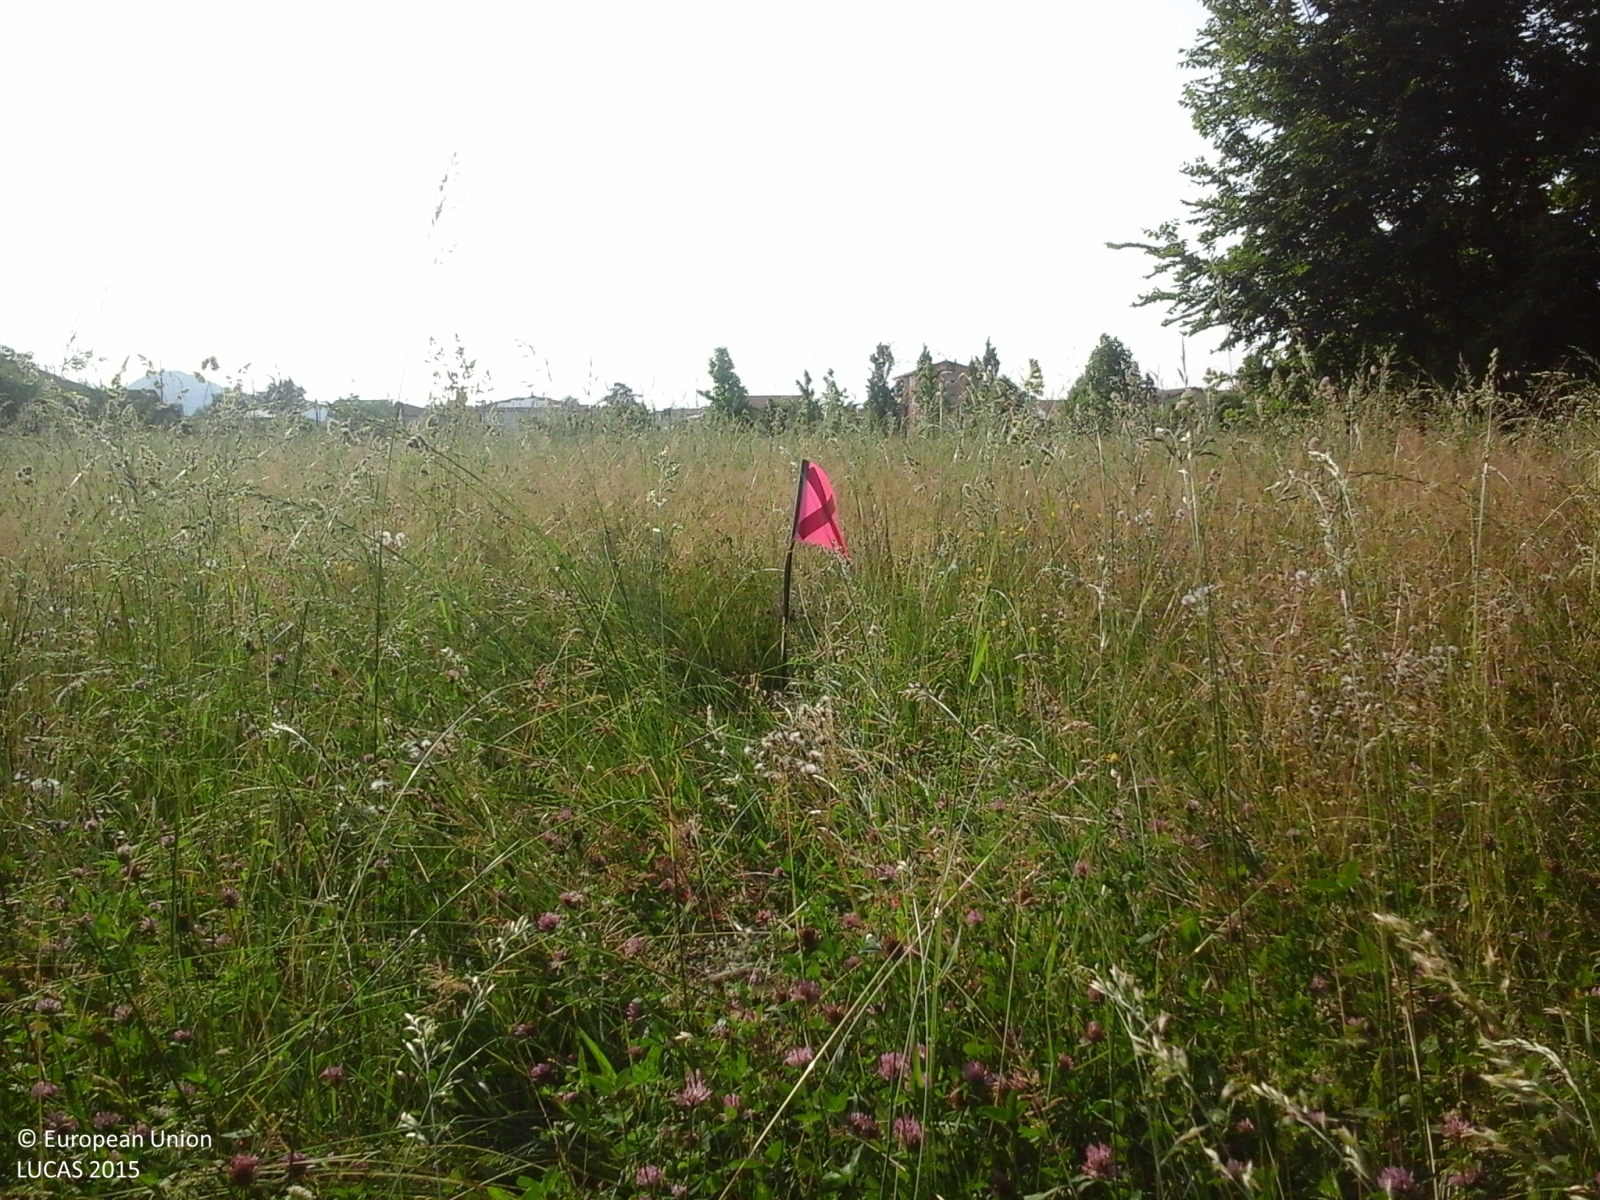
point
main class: Grassland
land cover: Grassland without tree/shrub cover
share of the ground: > 75 %
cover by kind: herbaceous plants 95 %, shrubs 5 %
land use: Agriculture (excluding fallow land and kitchen gardens)
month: May
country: IT
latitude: 45.3629
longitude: 11.7971
